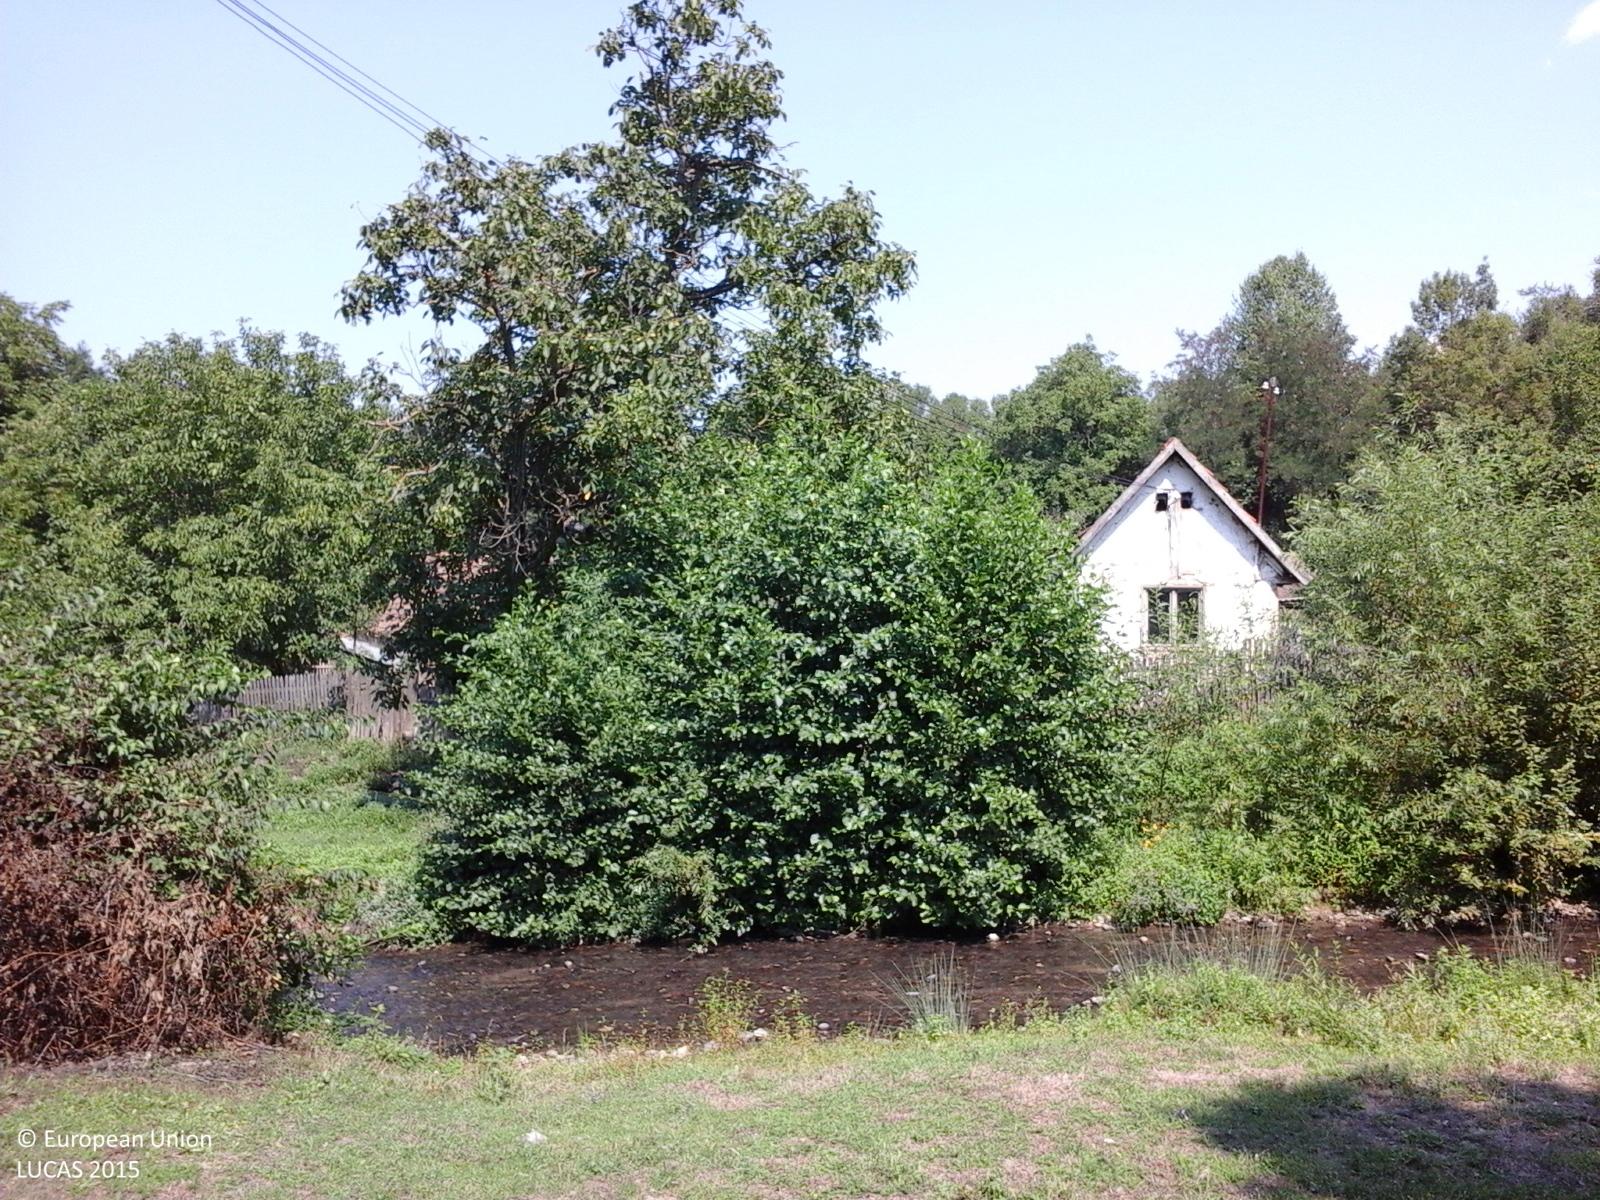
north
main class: Grassland
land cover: Grassland with sparse tree/shrub cover
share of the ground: > 75 %
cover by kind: herbaceous plants 85 %, shrubs 10 %, broadleaved forest trees 5 %
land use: Fallow land
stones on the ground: 10 - 25 %
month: August
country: RO
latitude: 46.2448
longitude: 22.0930
